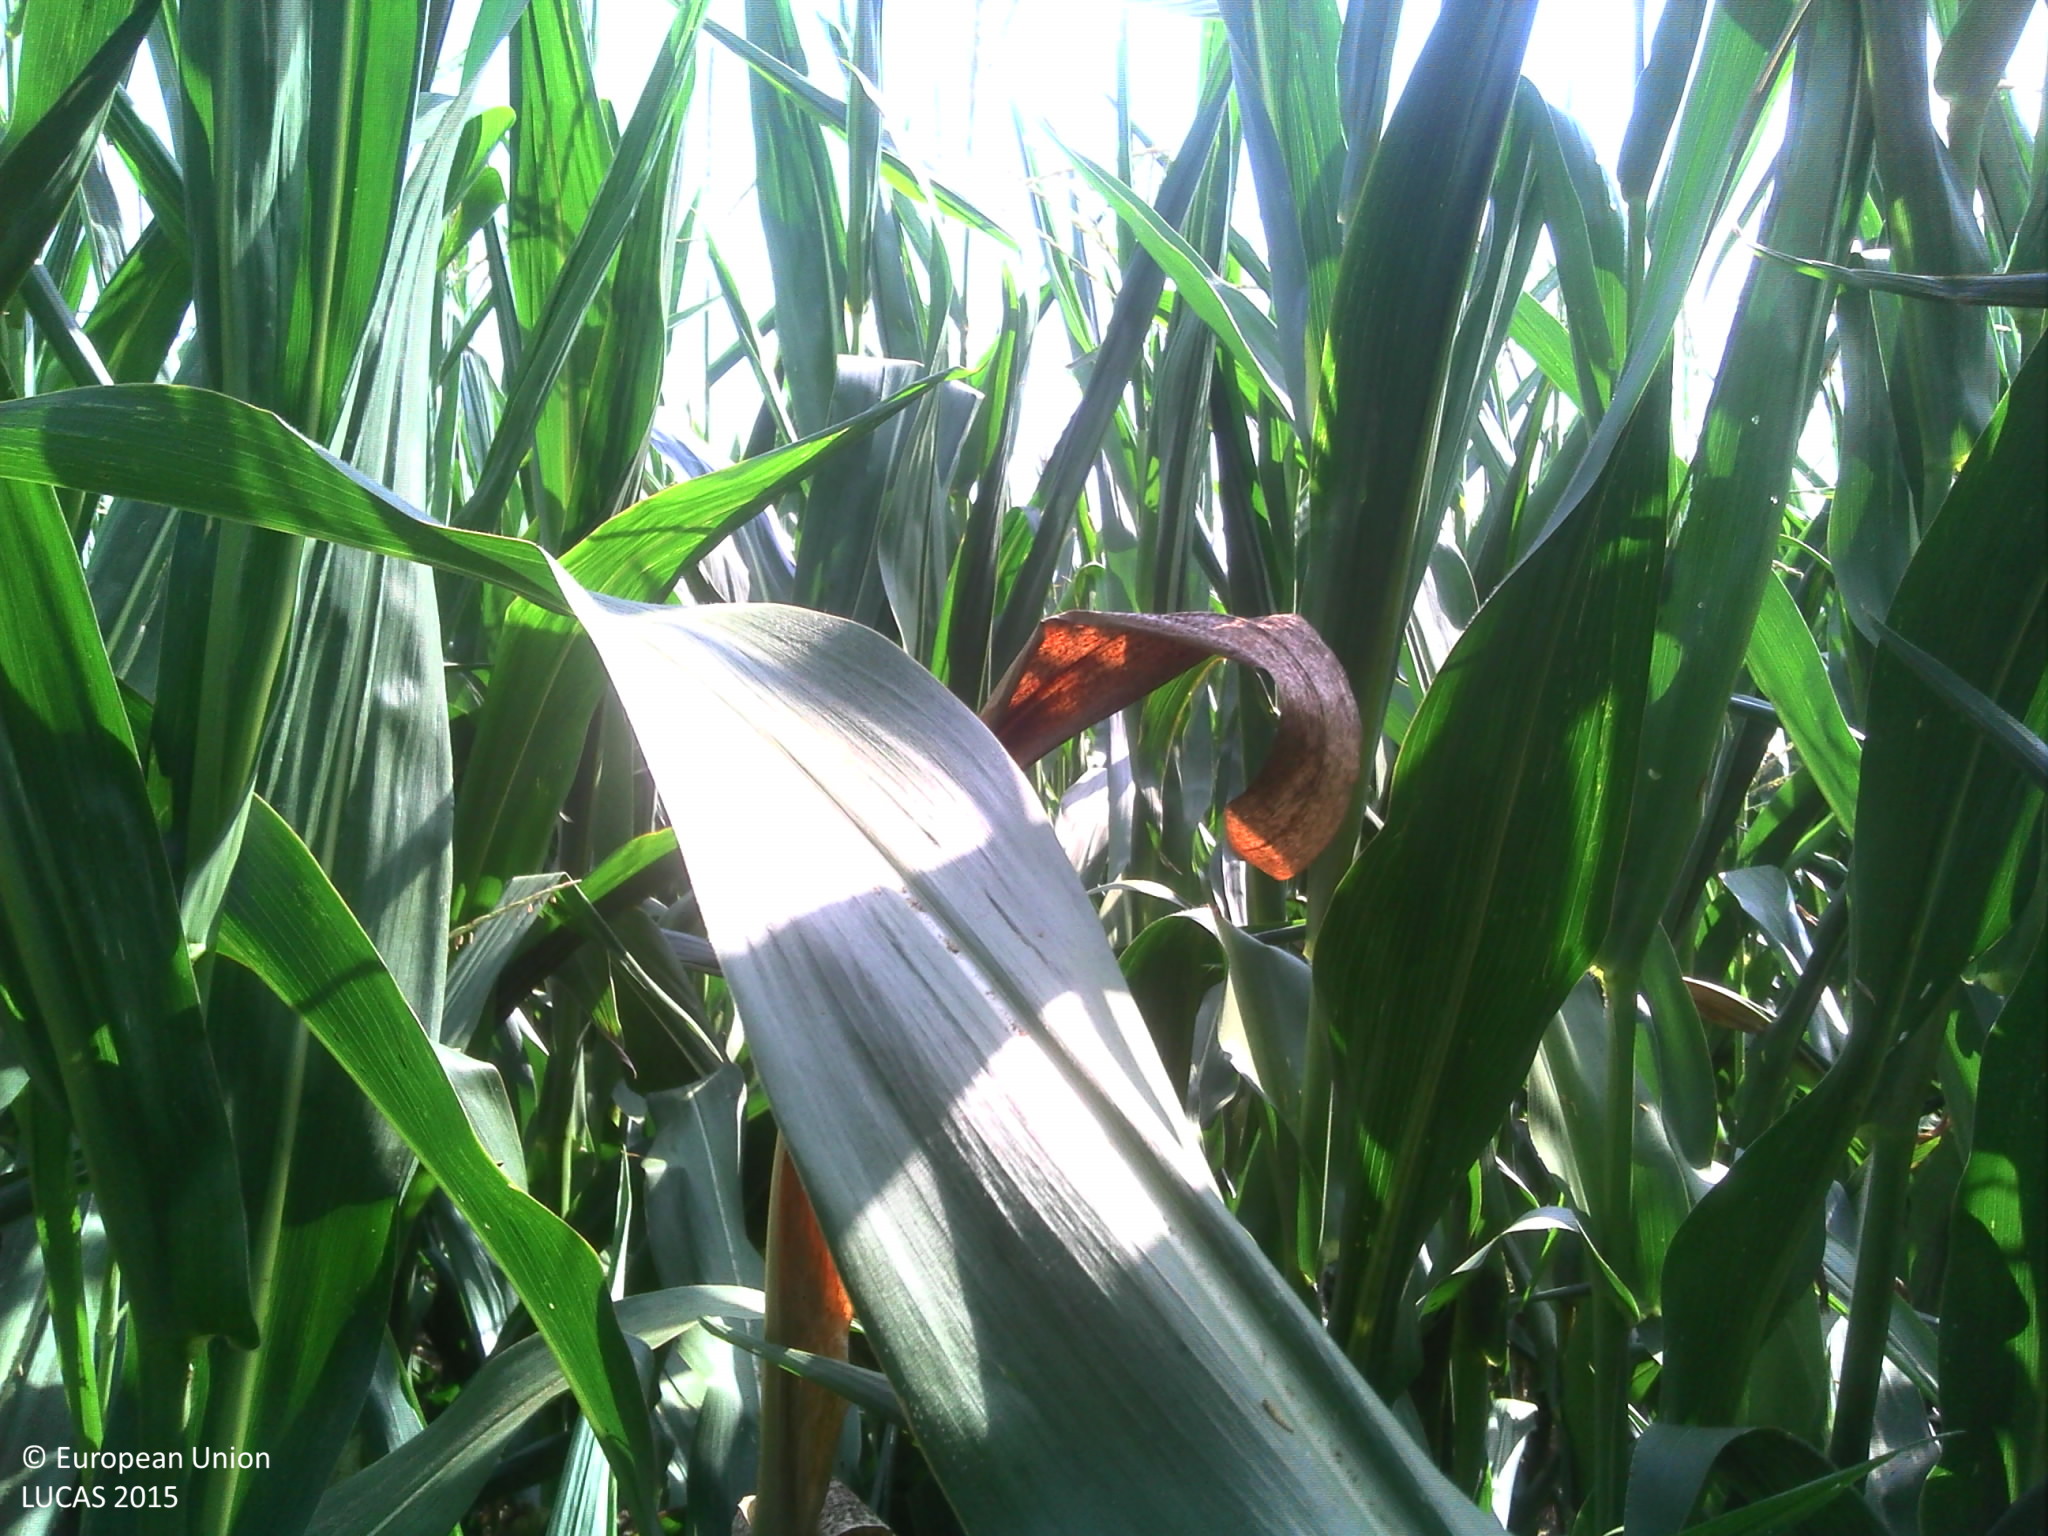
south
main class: Cropland
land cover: Maize
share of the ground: > 75 %
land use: Agriculture (excluding fallow land and kitchen gardens)
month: August
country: FR
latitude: 46.6727
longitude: -1.8469
